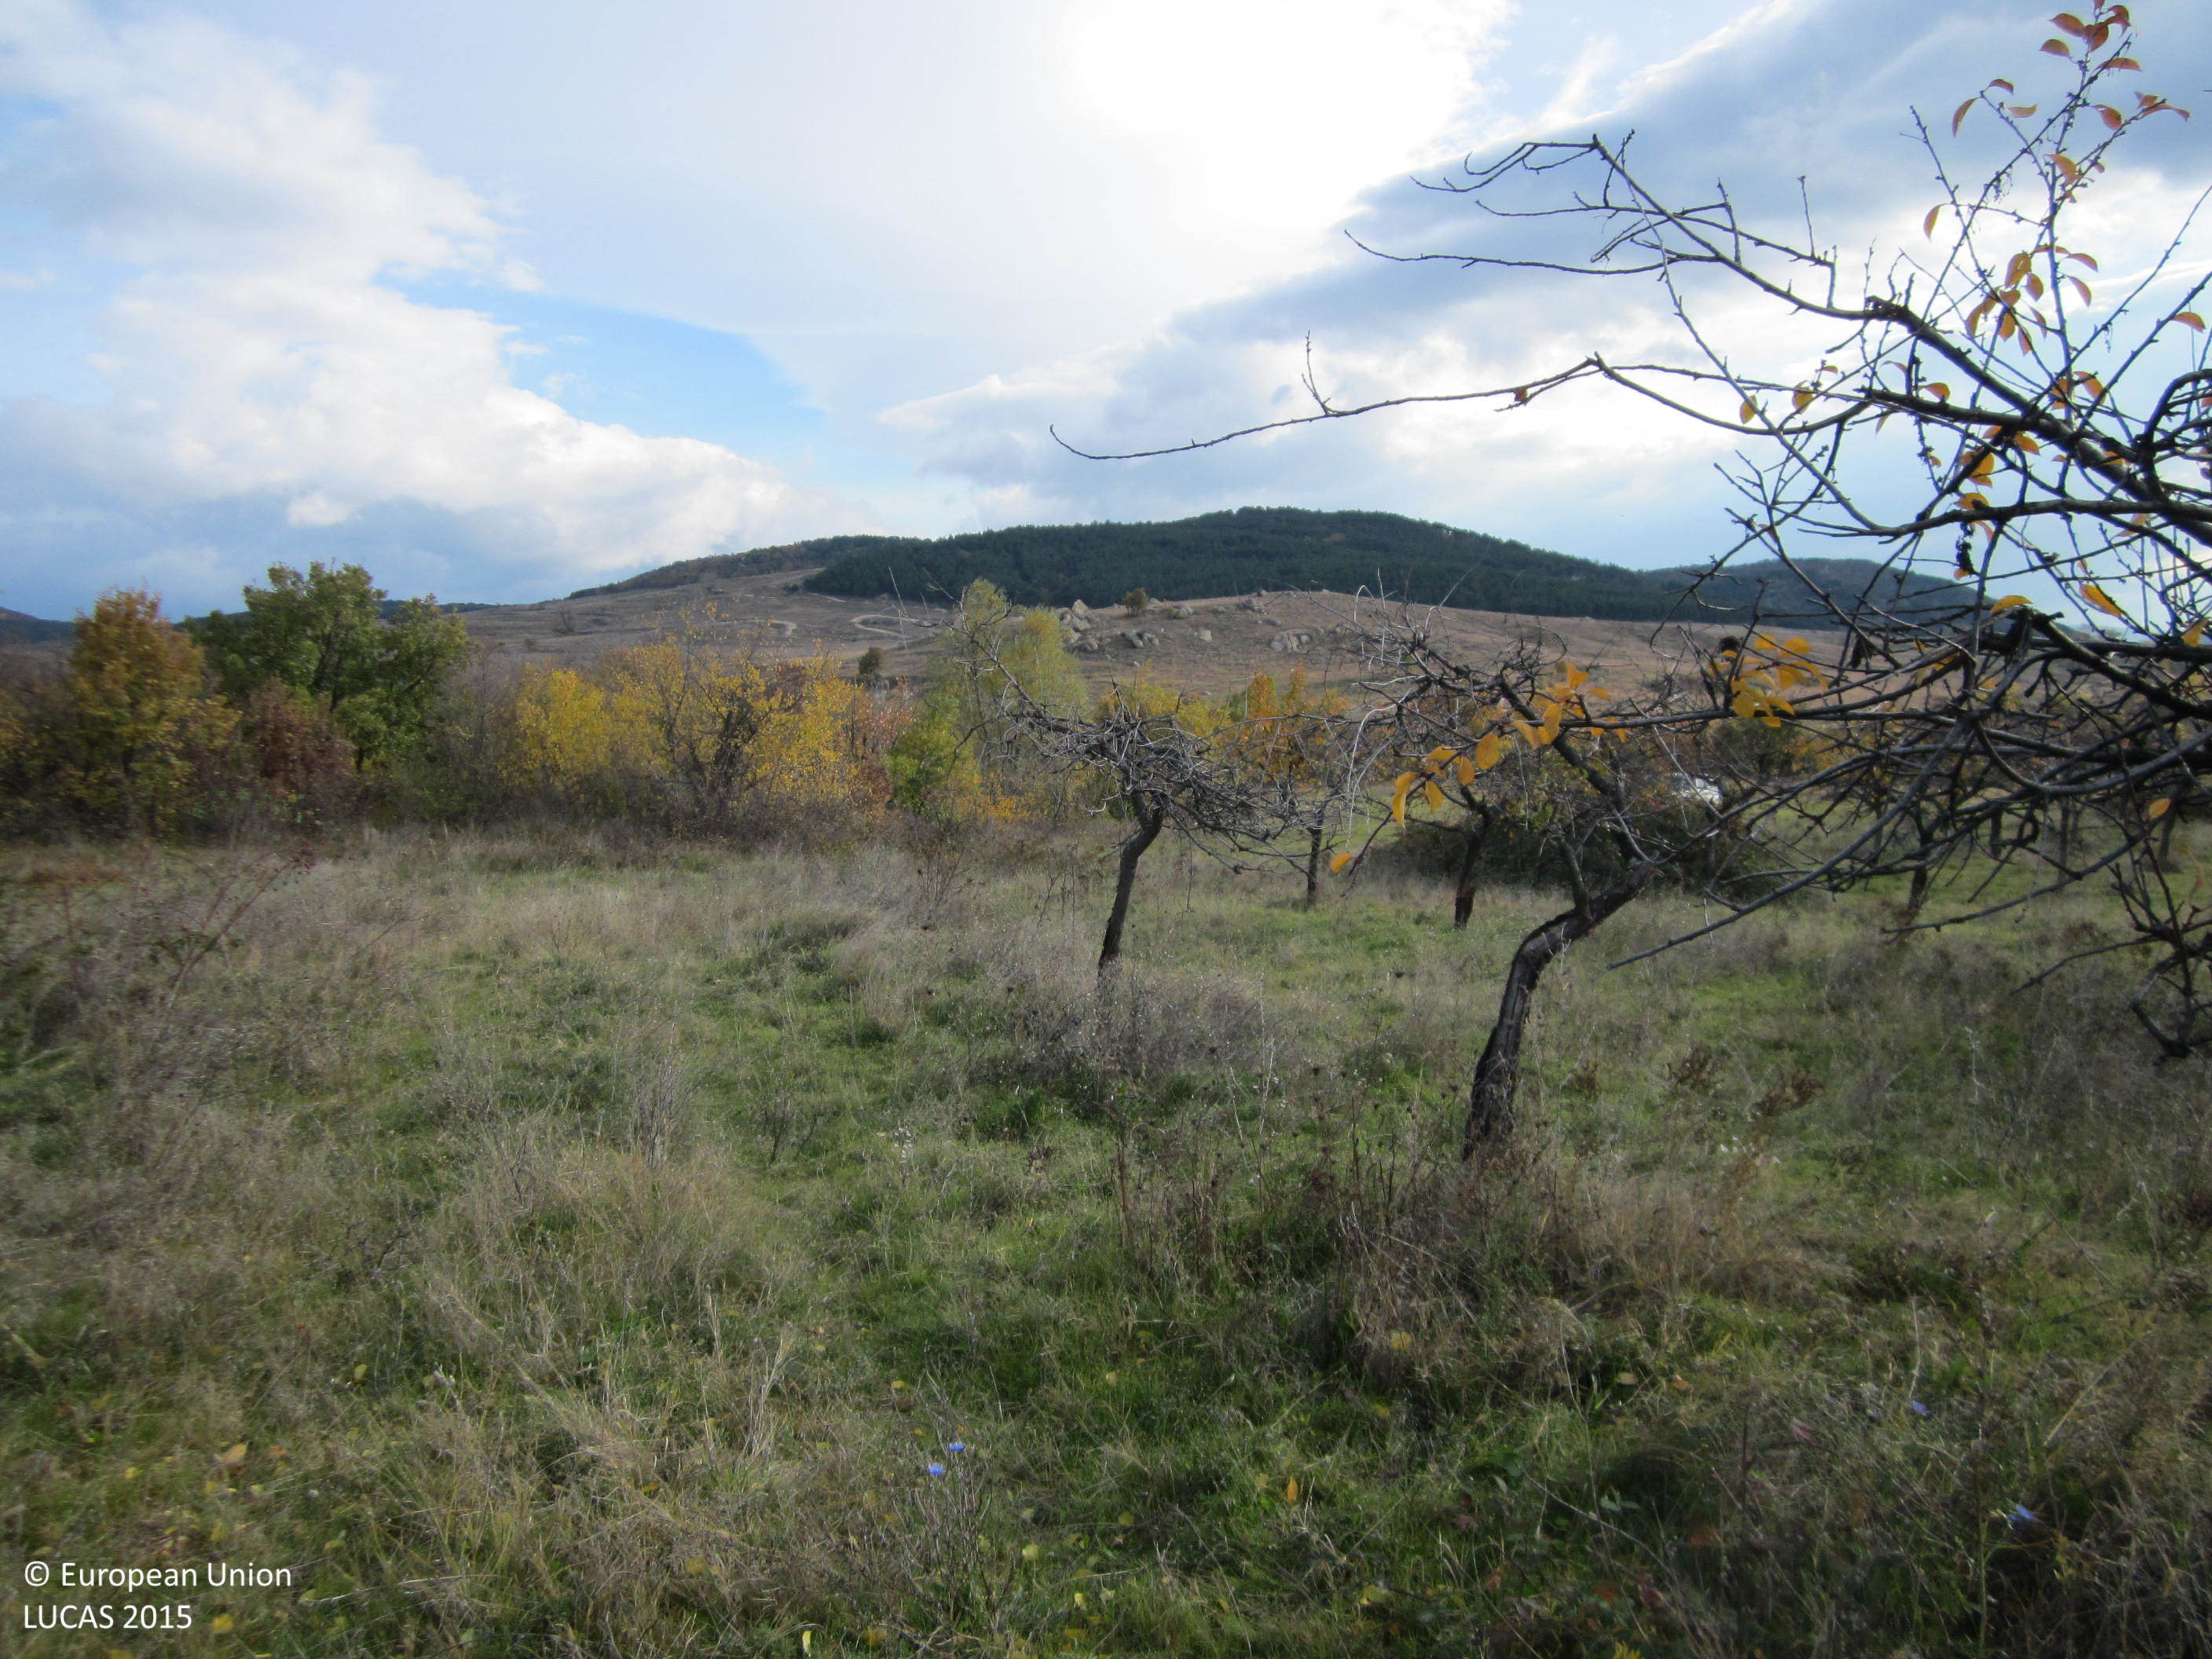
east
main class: Cropland
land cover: Cherry fruit
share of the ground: 50 - 75 %
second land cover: Grassland without tree/shrub cover
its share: > 75 %
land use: Agriculture (excluding fallow land and kitchen gardens)
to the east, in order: Cherry fruit; Grassland without tree/shrub cover; Grass margins; Tracks; Grassland without tree/shrub cover; Broadleaved woodland; Inland fresh water bodies; Grassland without tree/shrub cover; Tracks; Grassland with sparse tree/shrub cover
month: November
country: BG
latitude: 42.5276
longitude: 24.7001
